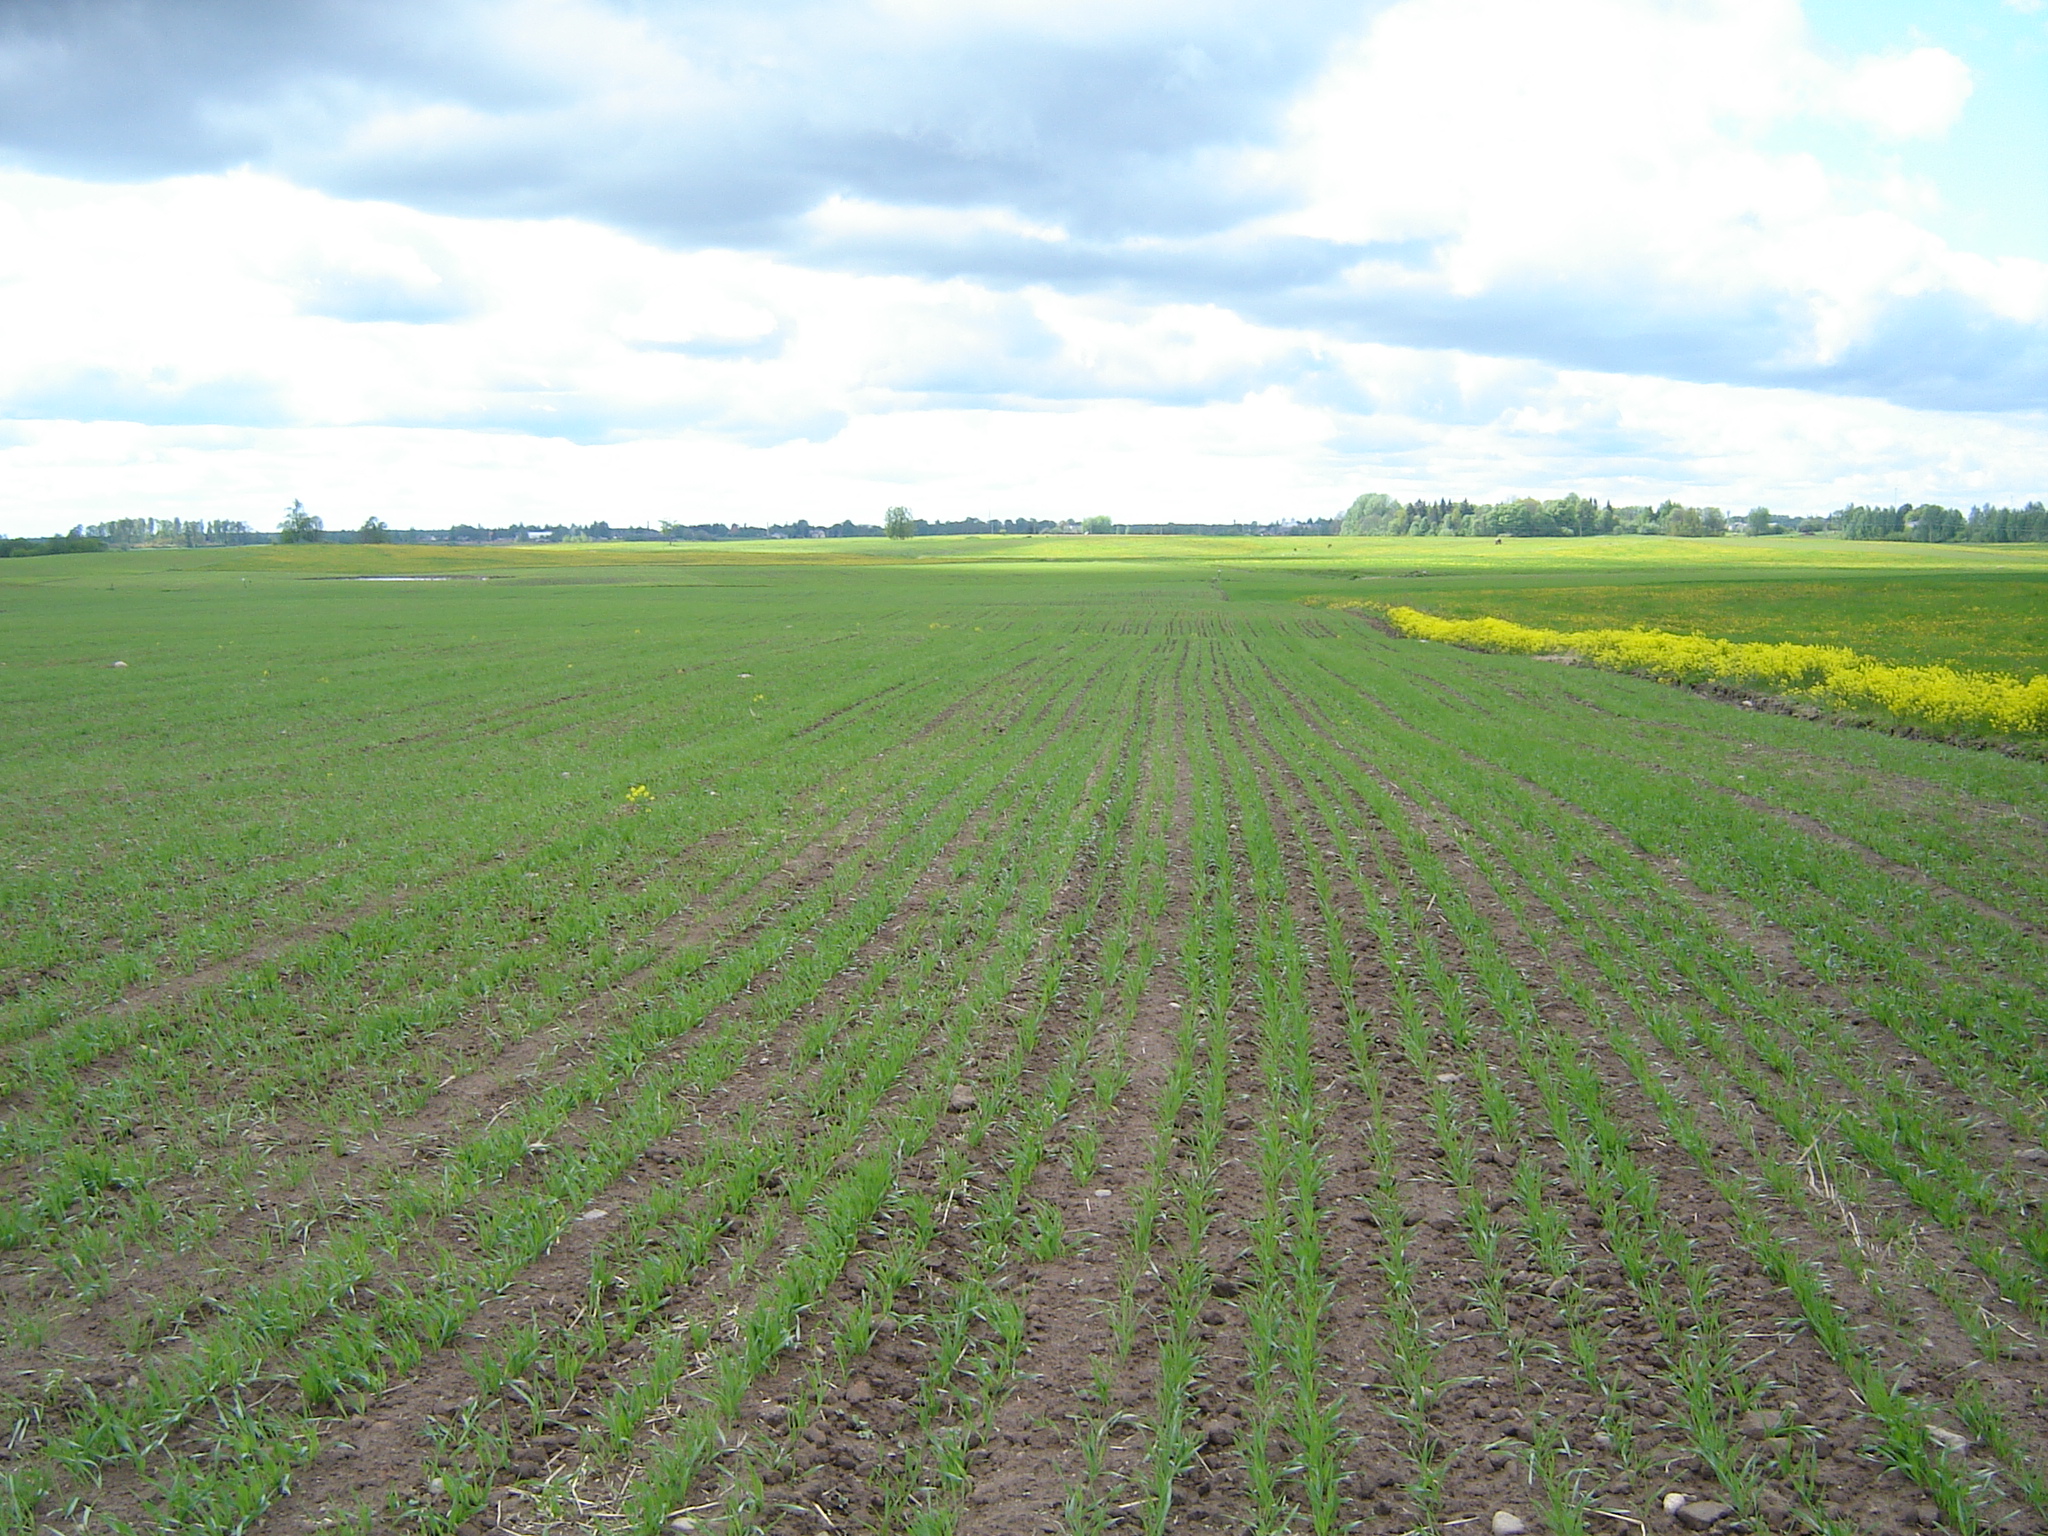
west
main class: Cropland
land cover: Barley
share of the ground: 25 - 50 %
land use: Agriculture (excluding fallow land and kitchen gardens)
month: May
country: LT
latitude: 56.0171
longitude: 25.2761
